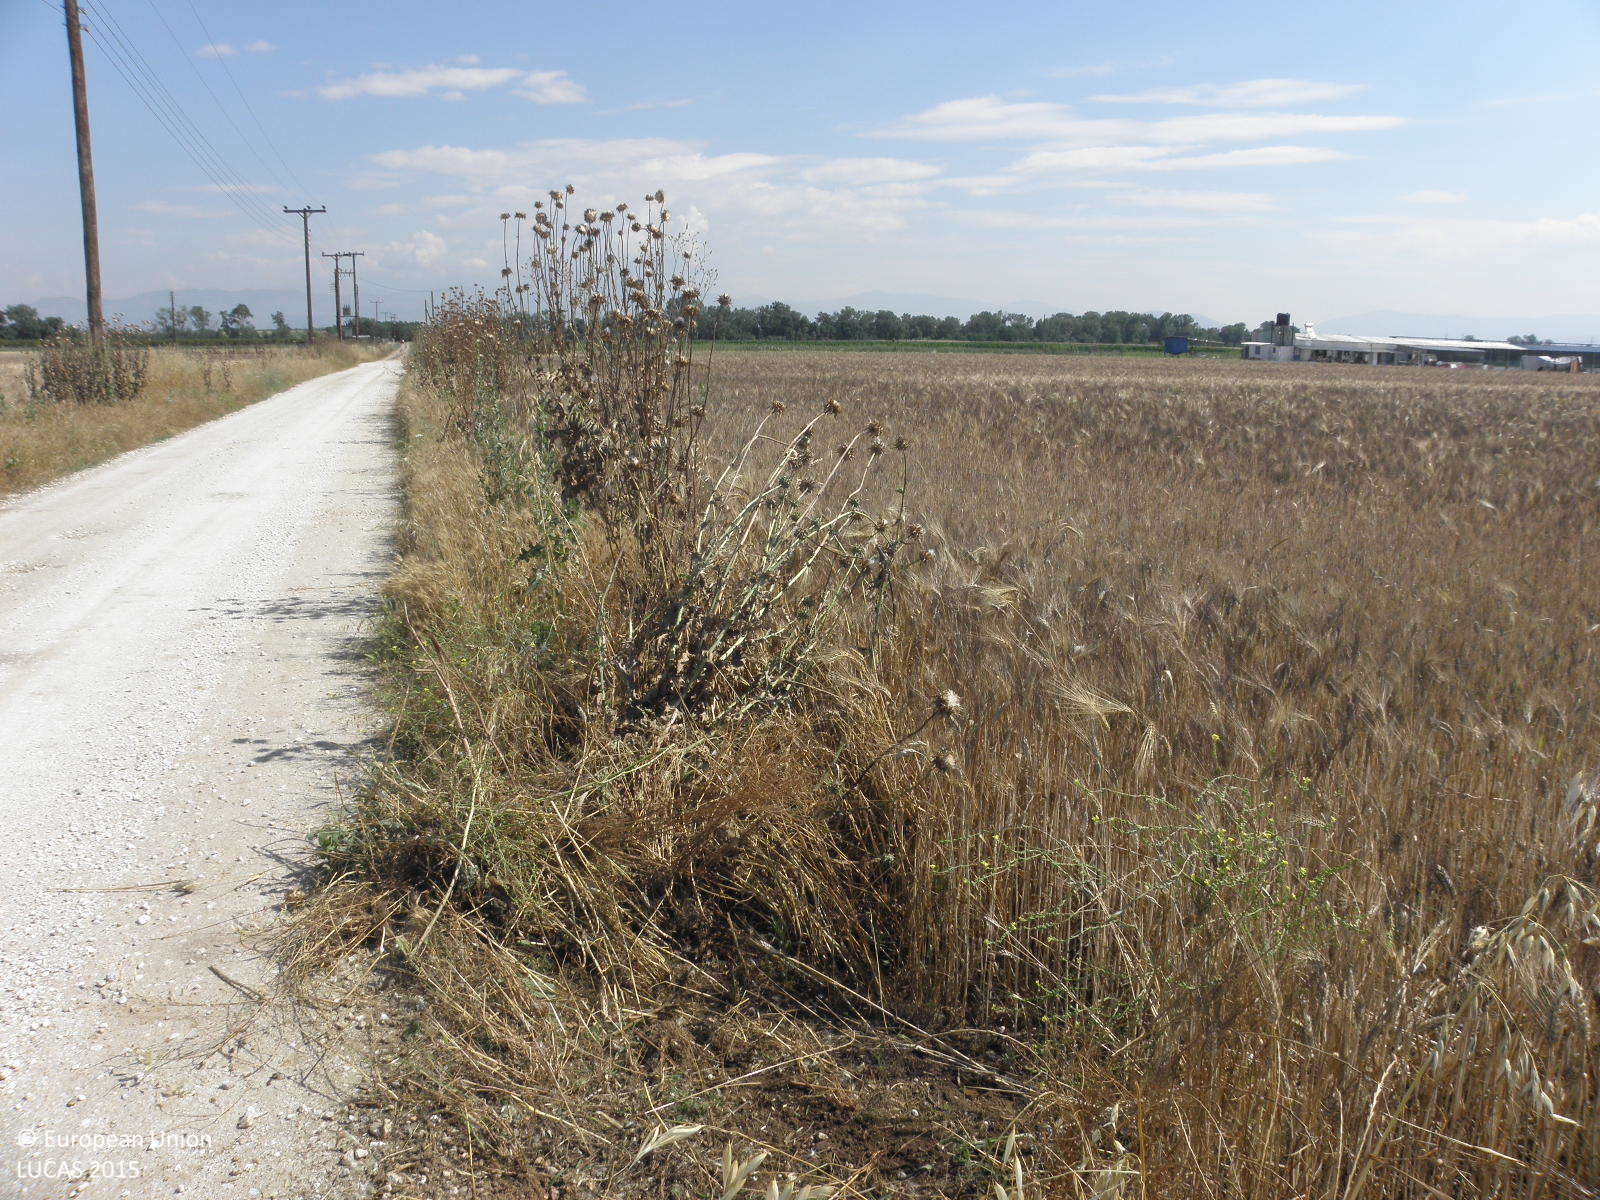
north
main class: Cropland
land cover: Durum wheat
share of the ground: > 75 %
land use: Agriculture (excluding fallow land and kitchen gardens)
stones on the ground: < 10 %
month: June
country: GR
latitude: 39.6508
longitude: 22.3309
